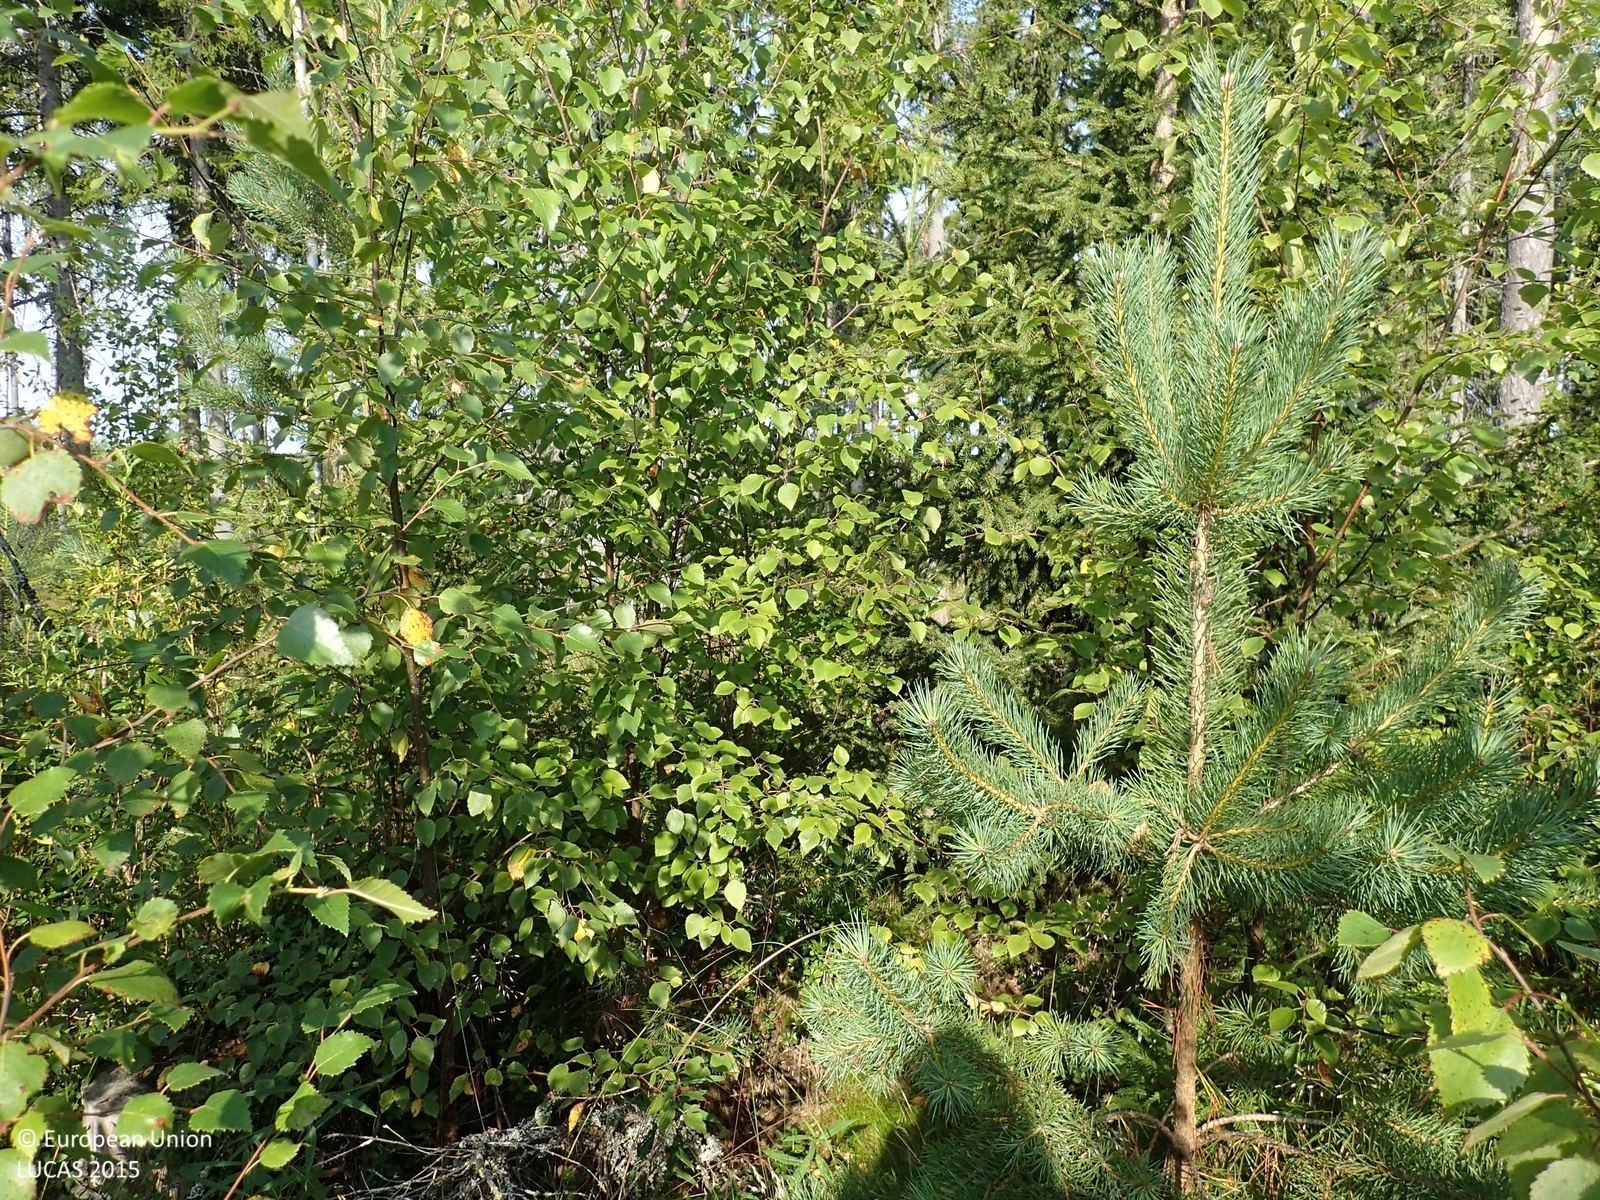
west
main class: Woodland
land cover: Other mixed woodland
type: boreal forest
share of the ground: > 75 %
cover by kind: broadleaved forest trees 55 %, coniferous forest trees 20 %, herbaceous plants 15 %, shrubs 10 %
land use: Forestry
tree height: < 5 m
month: August
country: FI
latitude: 62.6212
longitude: 22.0360
